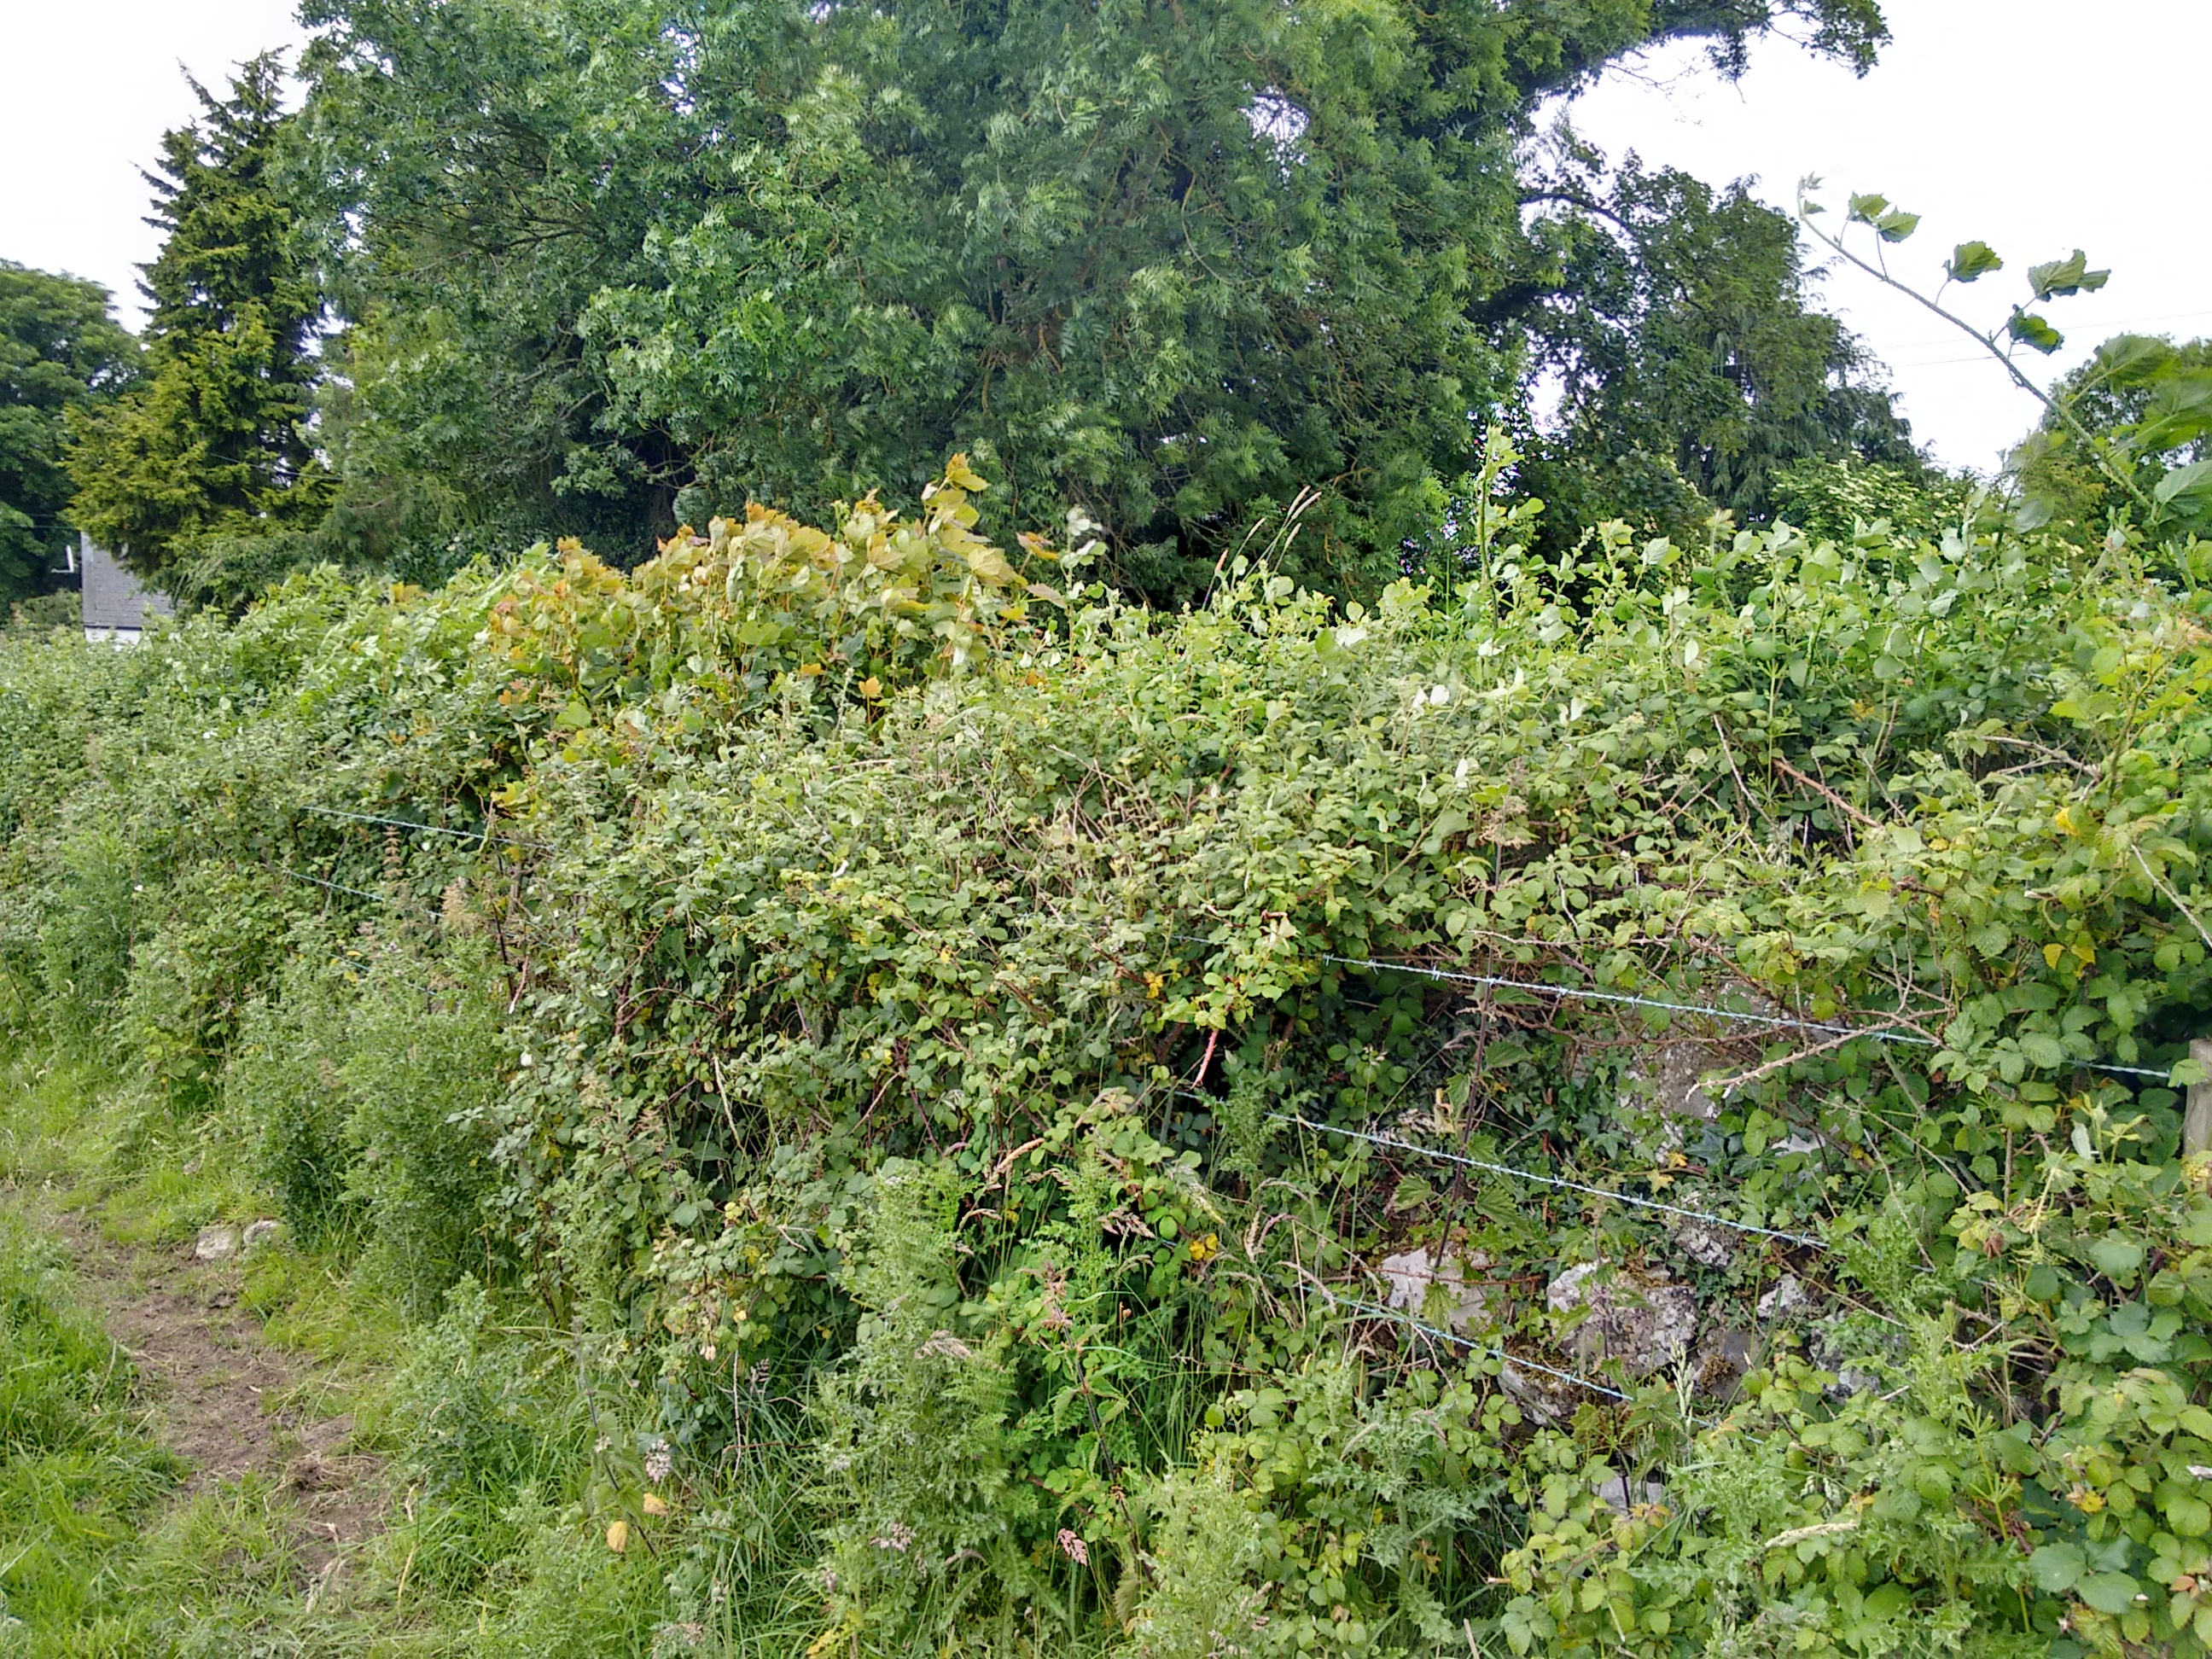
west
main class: Grassland
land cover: Grassland without tree/shrub cover
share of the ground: > 75 %
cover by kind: herbaceous plants 100 %
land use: Agriculture (excluding fallow land and kitchen gardens)
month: June
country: IE
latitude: 53.4070
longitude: -7.5957
